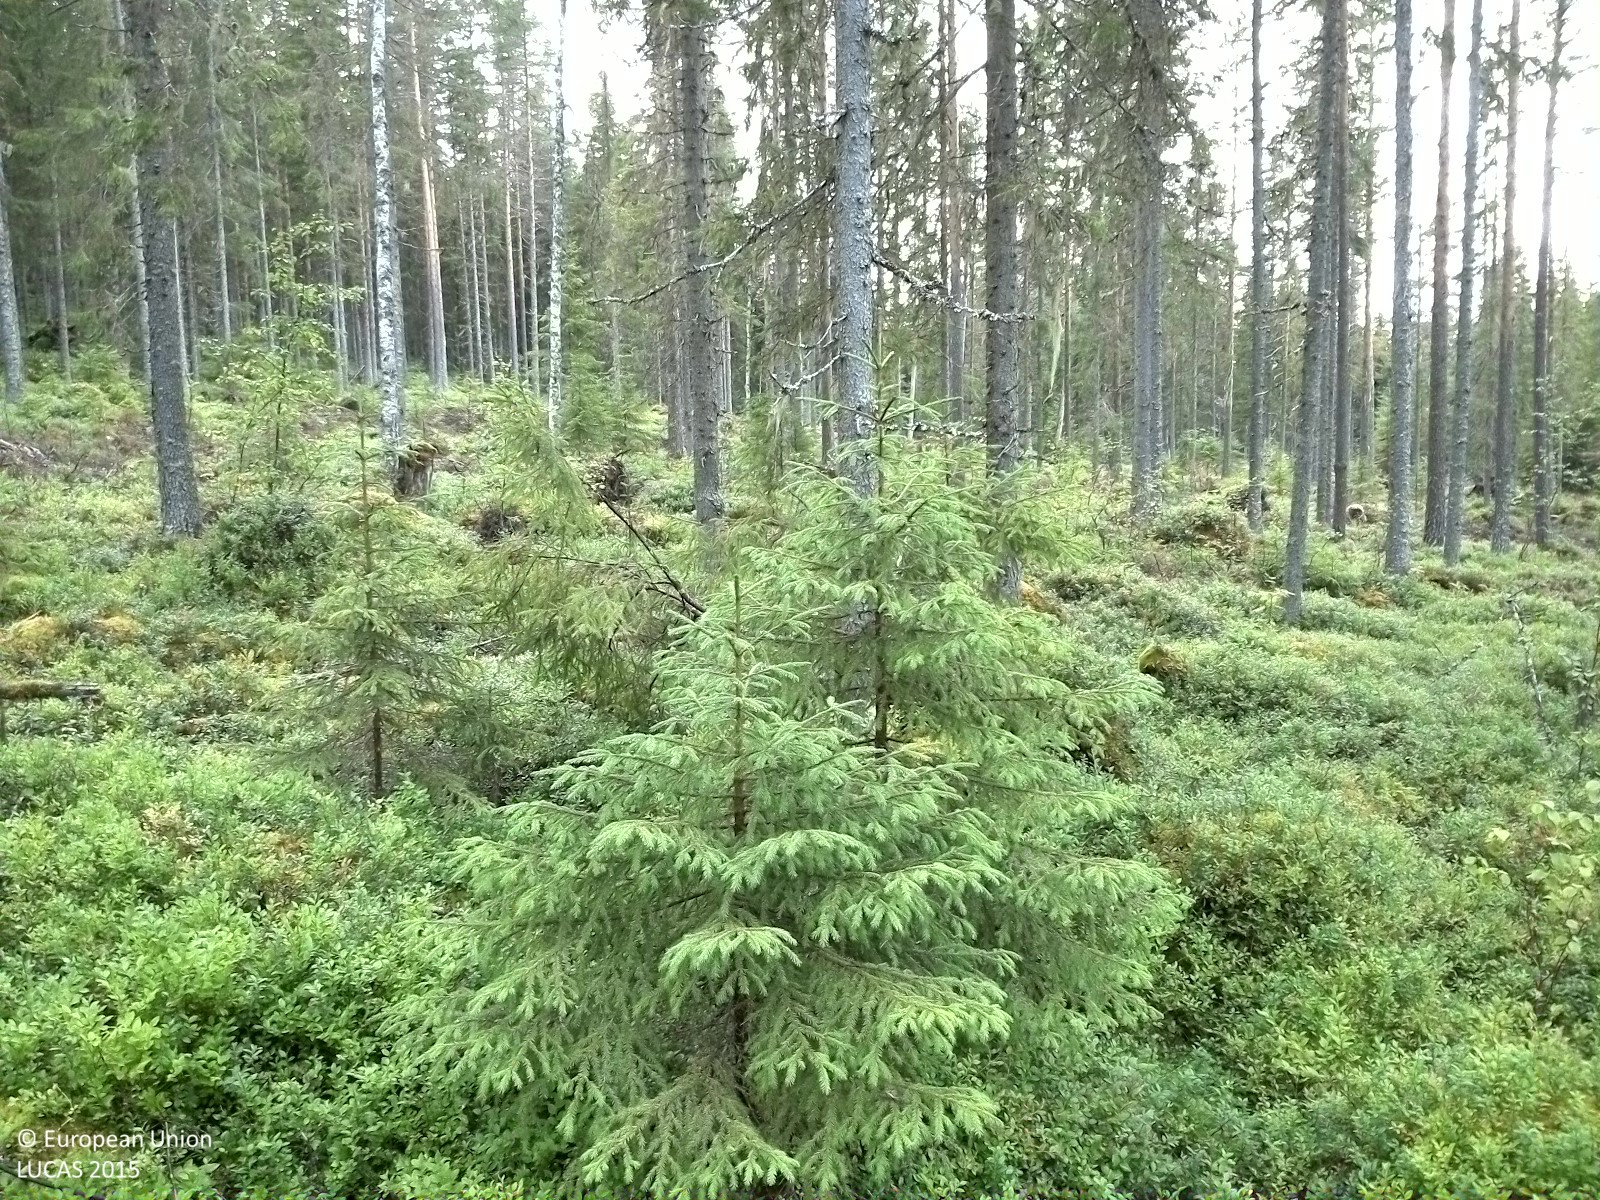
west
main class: Woodland
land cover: Spruce dominated coniferous woodland
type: boreal forest
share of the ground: 25 - 50 %
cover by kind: shrubs 70 %, coniferous forest trees 25 %, lichens and mosses 5 %
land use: Forestry
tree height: > 5 m
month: August
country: SE
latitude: 62.6670
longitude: 16.1668
